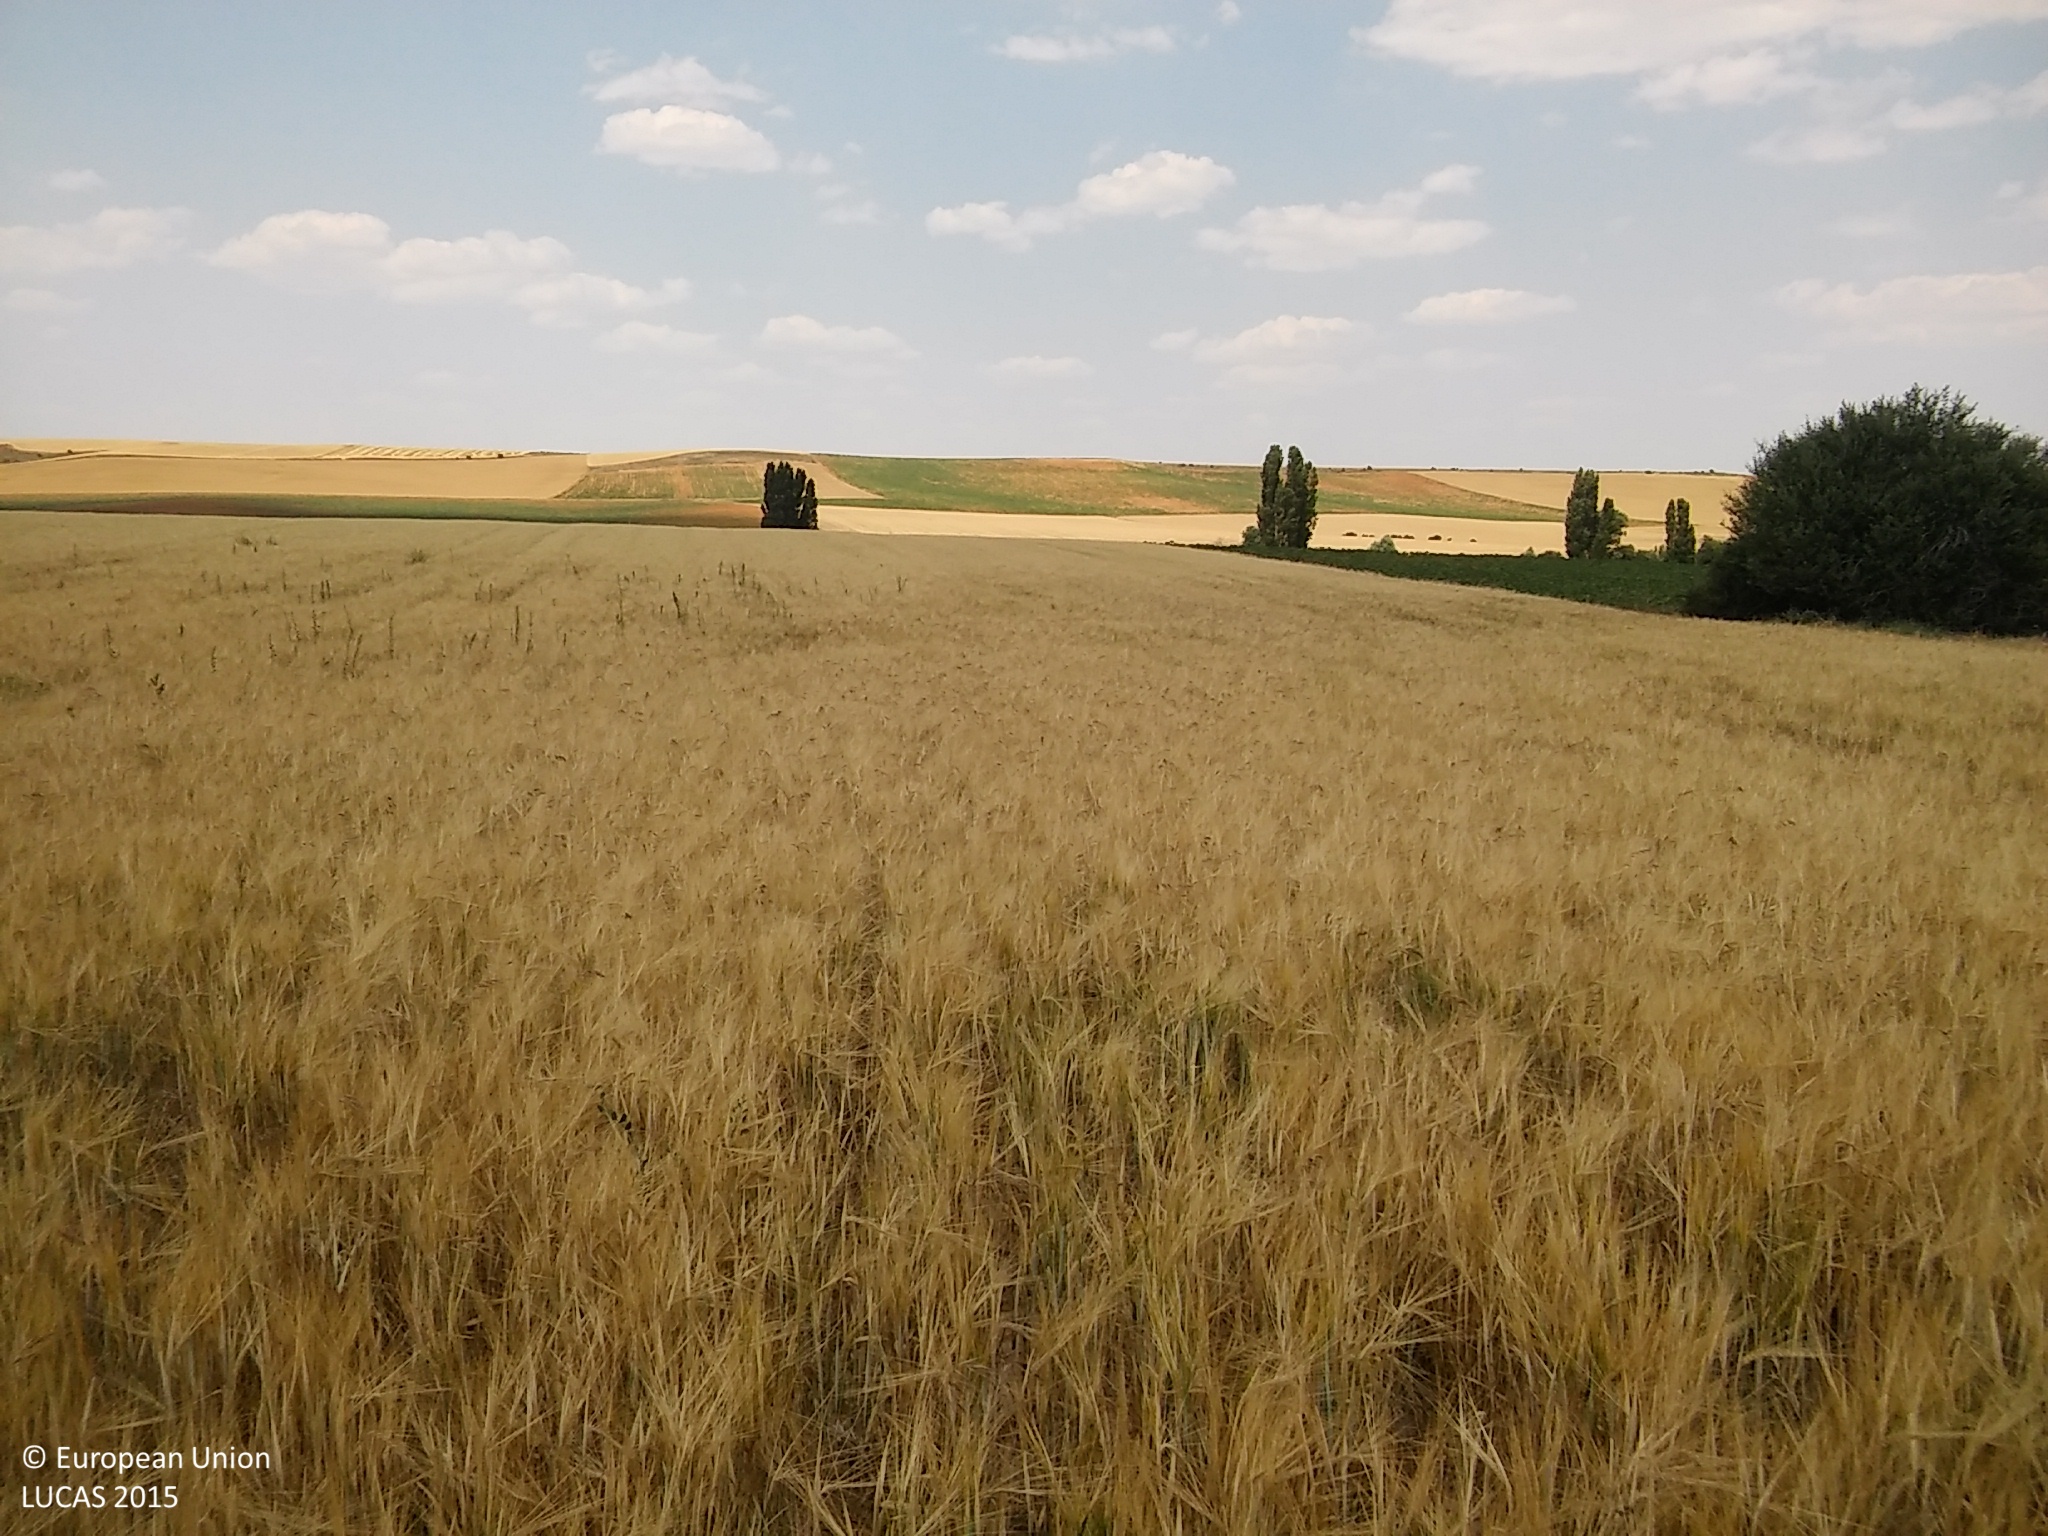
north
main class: Cropland
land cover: Barley
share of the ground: > 75 %
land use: Agriculture (excluding fallow land and kitchen gardens)
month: June
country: ES
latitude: 41.3913
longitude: -3.5498
